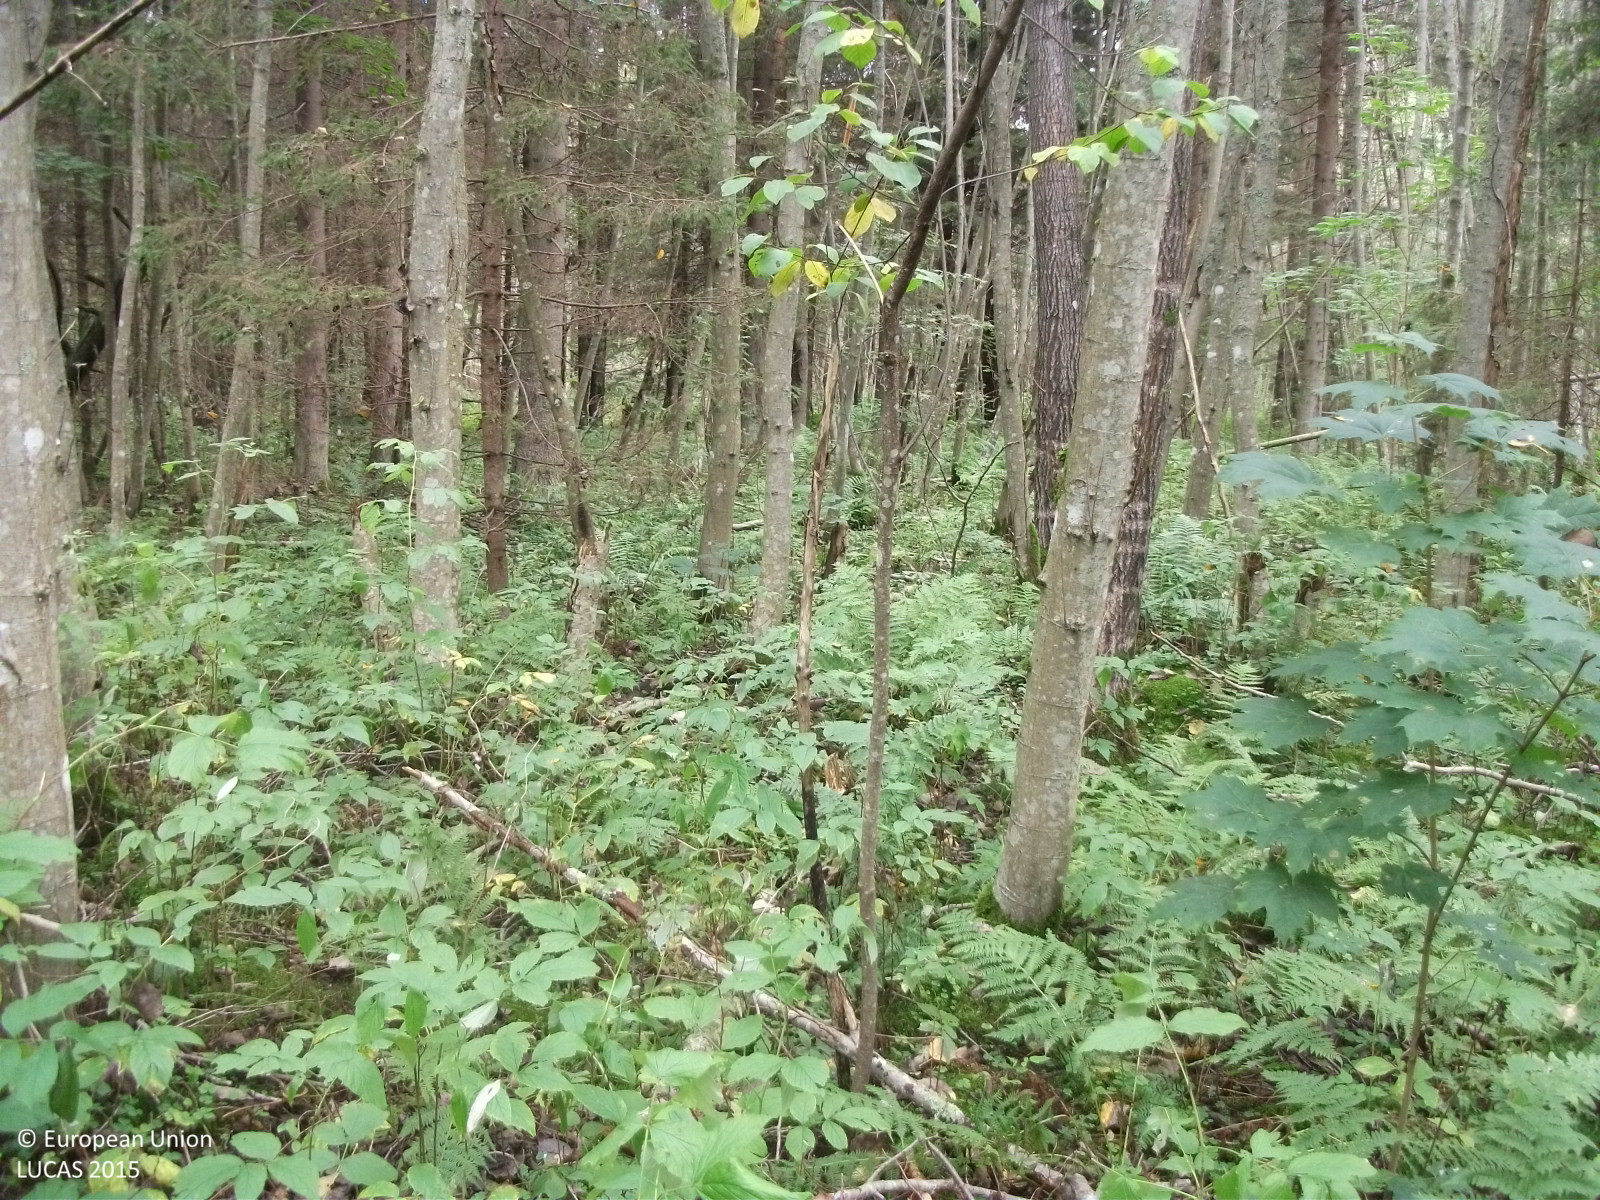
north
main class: Woodland
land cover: Spruce dominated mixed woodland
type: hemiboreal forest and nemoral coniferous forest and mixed broadleaved-coniferous forest
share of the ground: > 75 %
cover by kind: broadleaved forest trees 70 %, coniferous forest trees 25 %, herbaceous plants 5 %
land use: Forestry
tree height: > 5 m
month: September
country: LV
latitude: 57.6803
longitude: 24.5297
